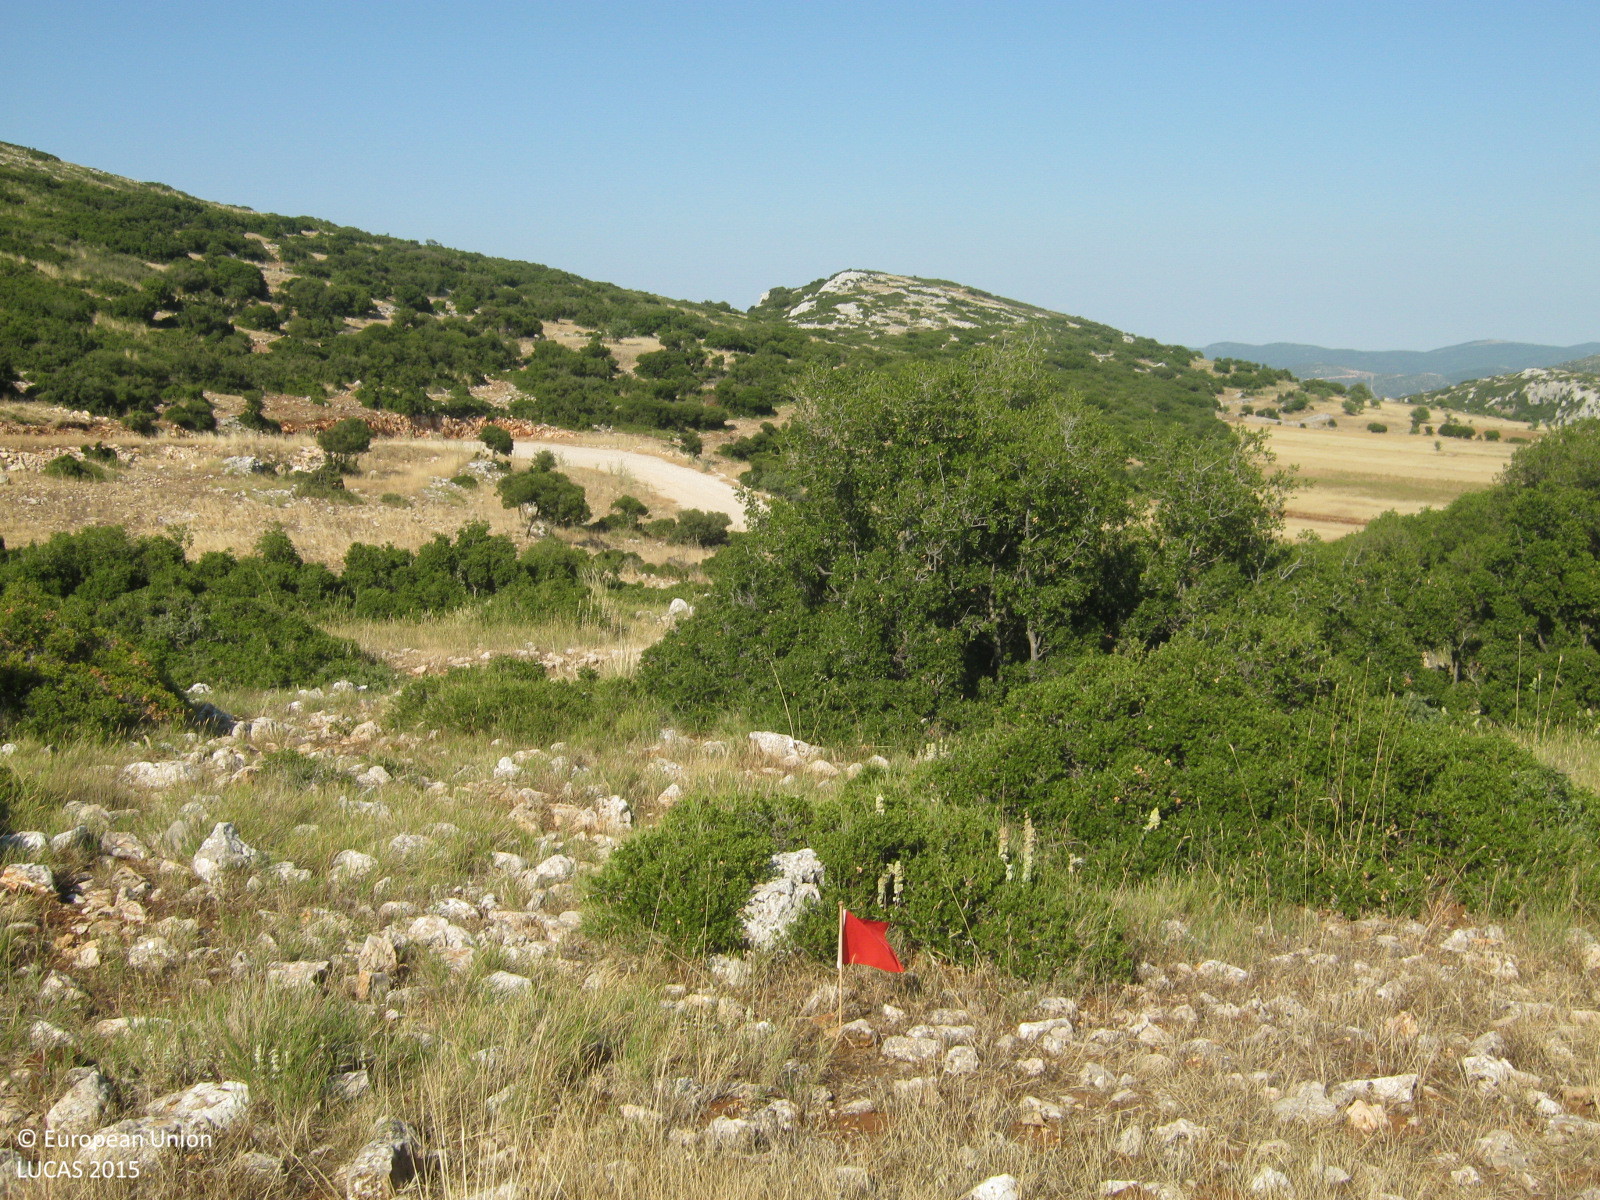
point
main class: Shrubland
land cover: Shrubland without tree cover
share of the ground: 25 - 50 %
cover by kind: shrubs 45 %, unconsolidated bare surface 40 %, herbaceous plants 15 %
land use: Semi-natural and natural areas not in use
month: July
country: GR
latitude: 37.7697
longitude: 22.8542
